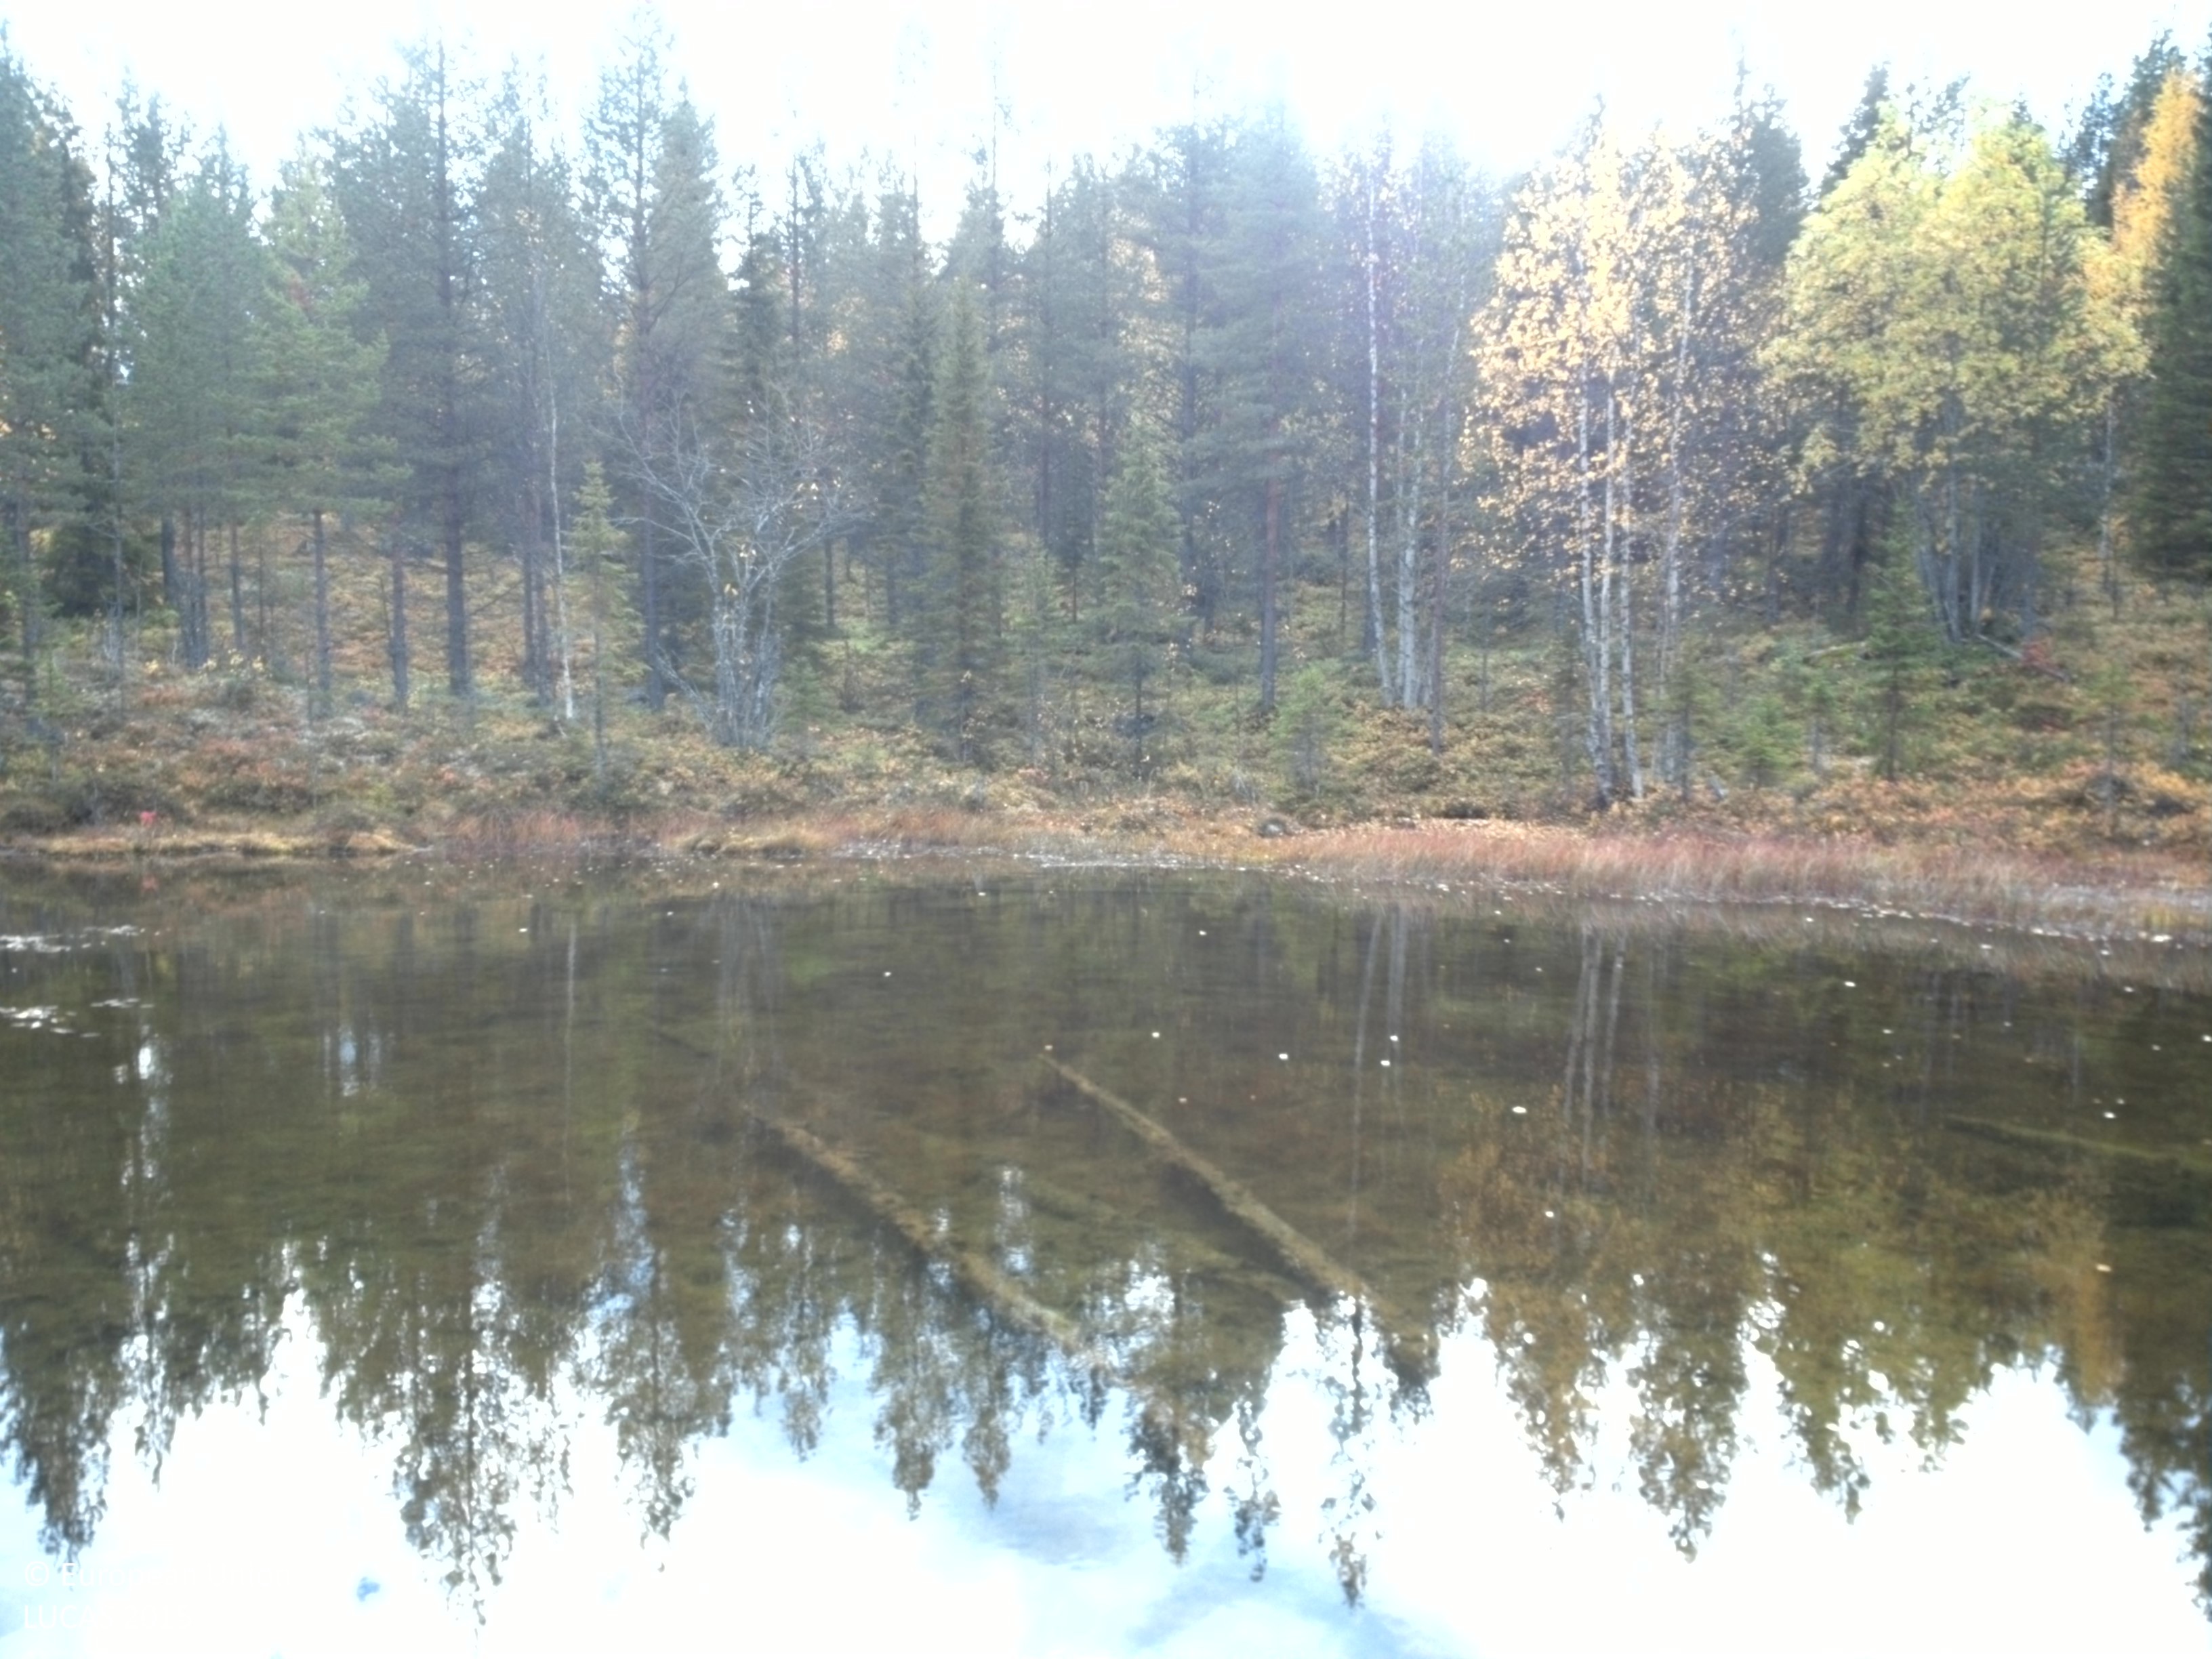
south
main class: Shrubland
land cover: Shrubland with sparse tree cover
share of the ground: 50 - 75 %
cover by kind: shrubs 70 %, lichens and mosses 15 %, herbaceous plants 10 %, broadleaved forest trees 5 %
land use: Semi-natural and natural areas not in use
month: September
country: SE
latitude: 64.8446
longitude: 17.7448
